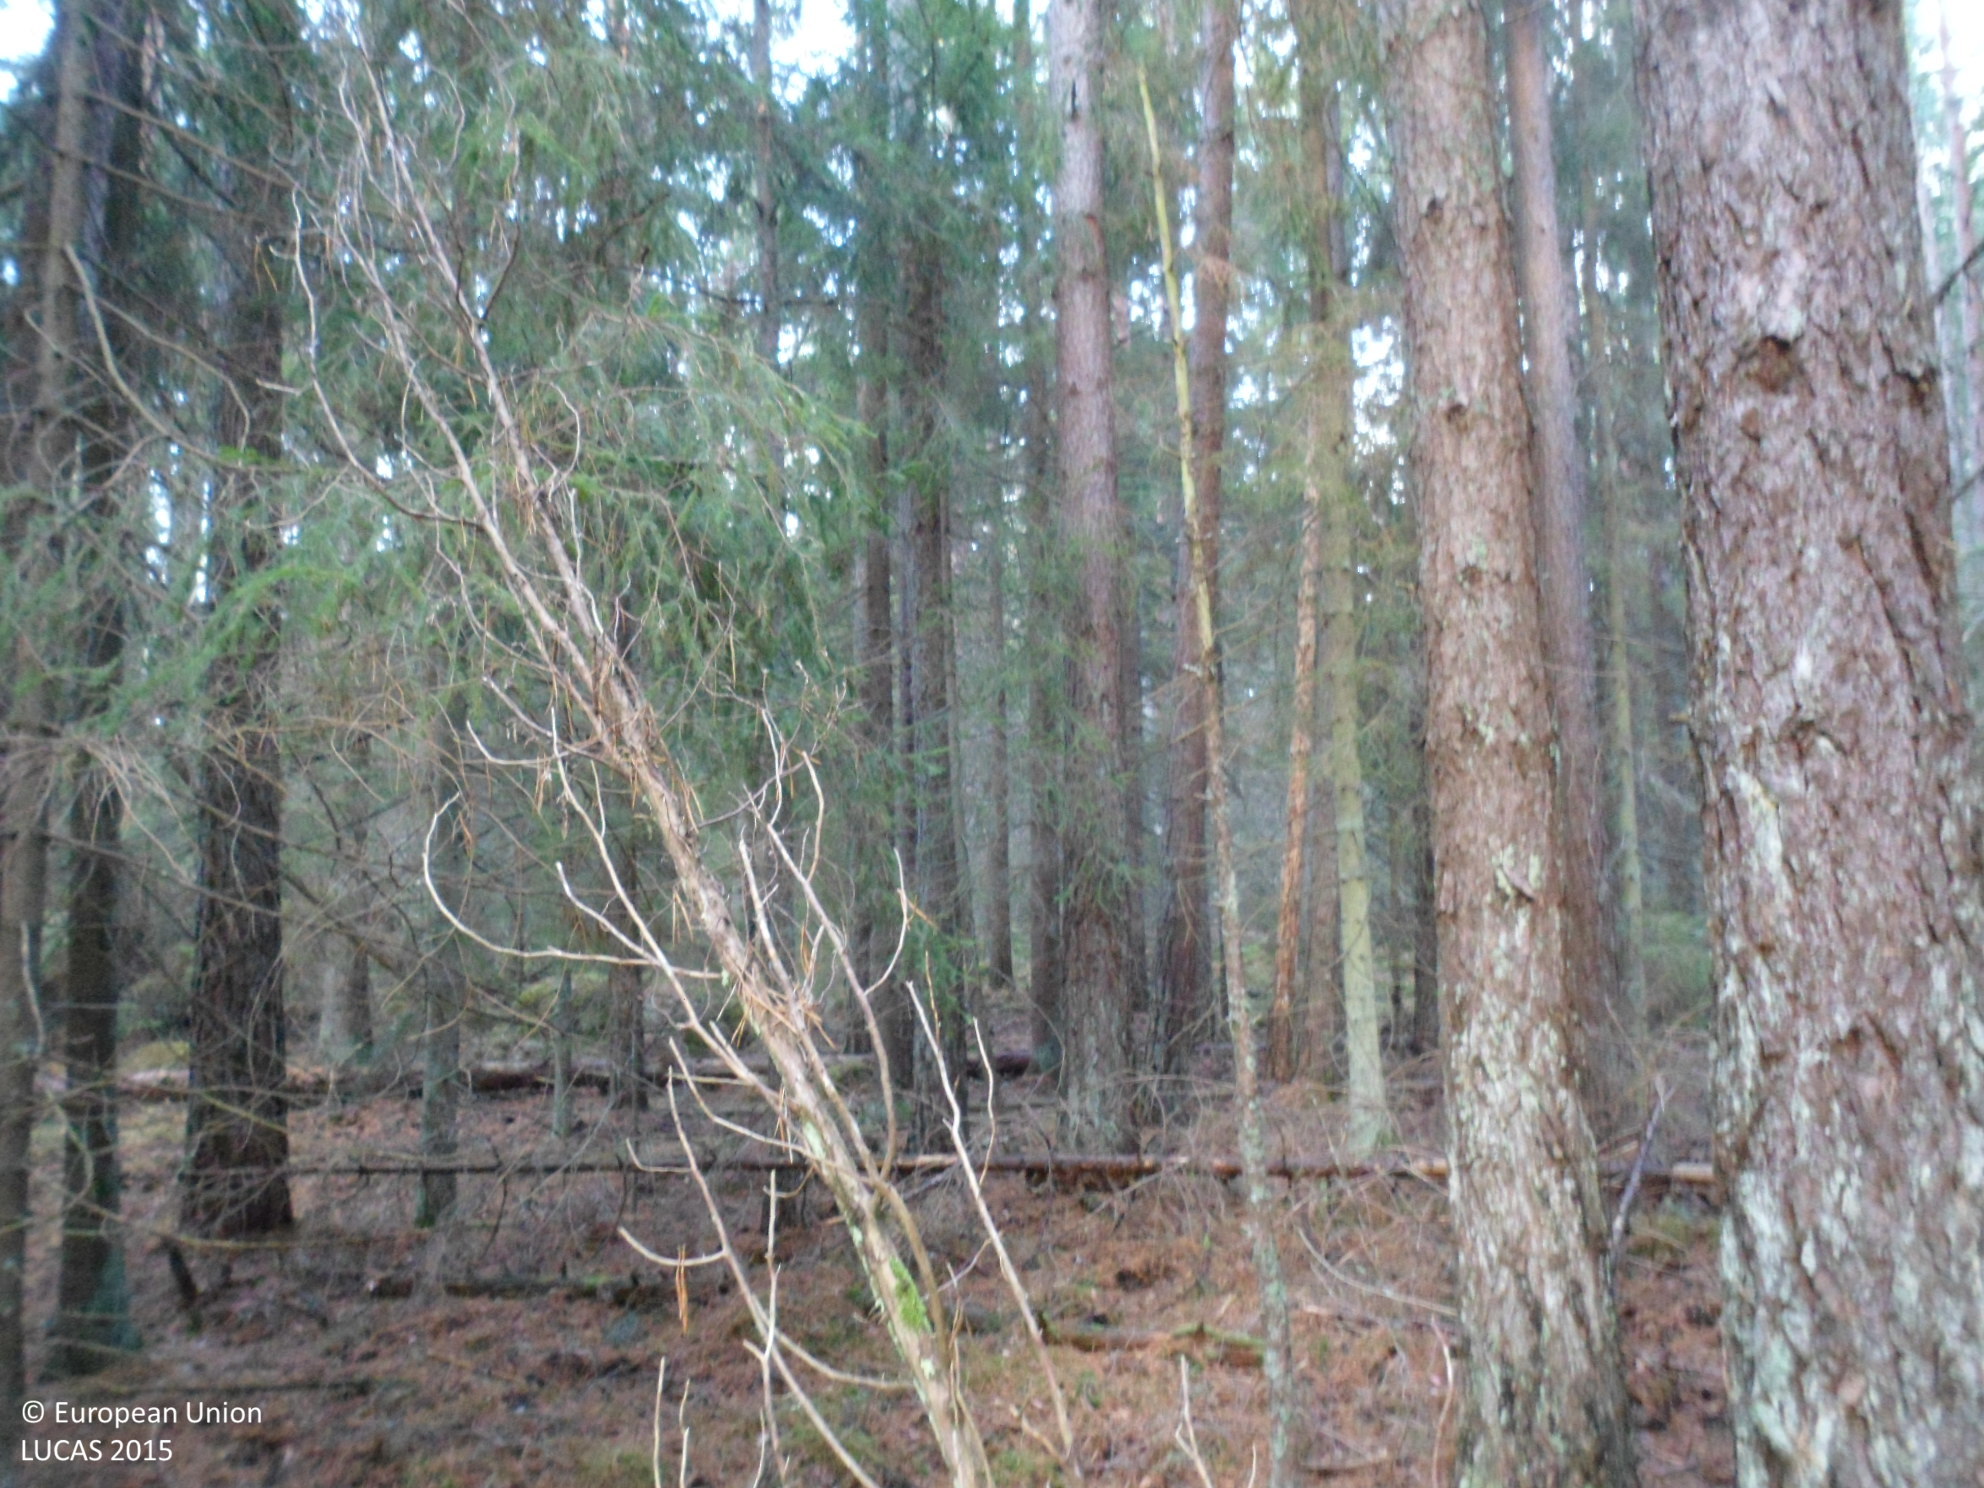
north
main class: Woodland
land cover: Other coniferous woodland
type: boreal forest
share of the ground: 50 - 75 %
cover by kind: coniferous forest trees 60 %, lichens and mosses 20 %, shrubs 15 %, unconsolidated bare surface 5 %
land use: Forestry
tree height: > 5 m
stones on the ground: 10 - 25 %
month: November
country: SE
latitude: 56.9118
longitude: 16.0269
